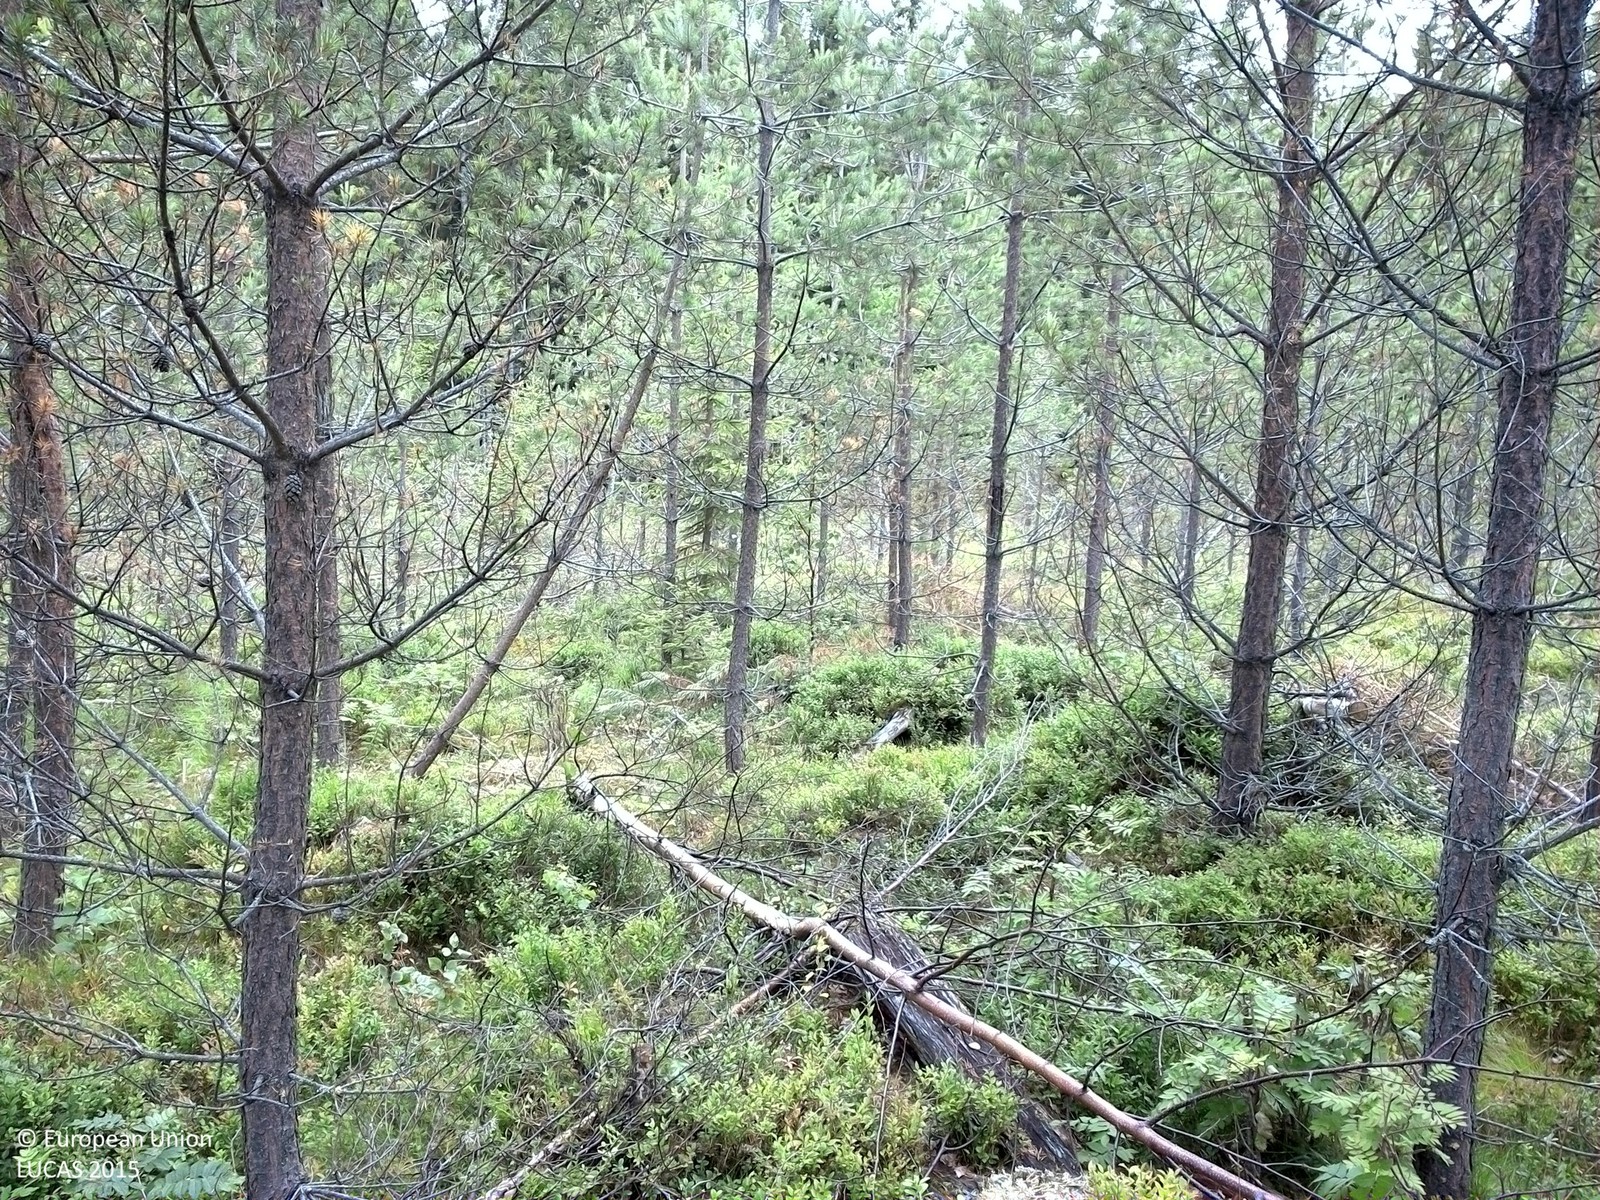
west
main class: Woodland
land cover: Pine dominated coniferous woodland
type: boreal forest
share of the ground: 50 - 75 %
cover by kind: coniferous forest trees 50 %, shrubs 35 %, lichens and mosses 10 %, herbaceous plants 5 %
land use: Forestry
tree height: > 5 m
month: August
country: SE
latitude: 63.7013
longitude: 16.5474
